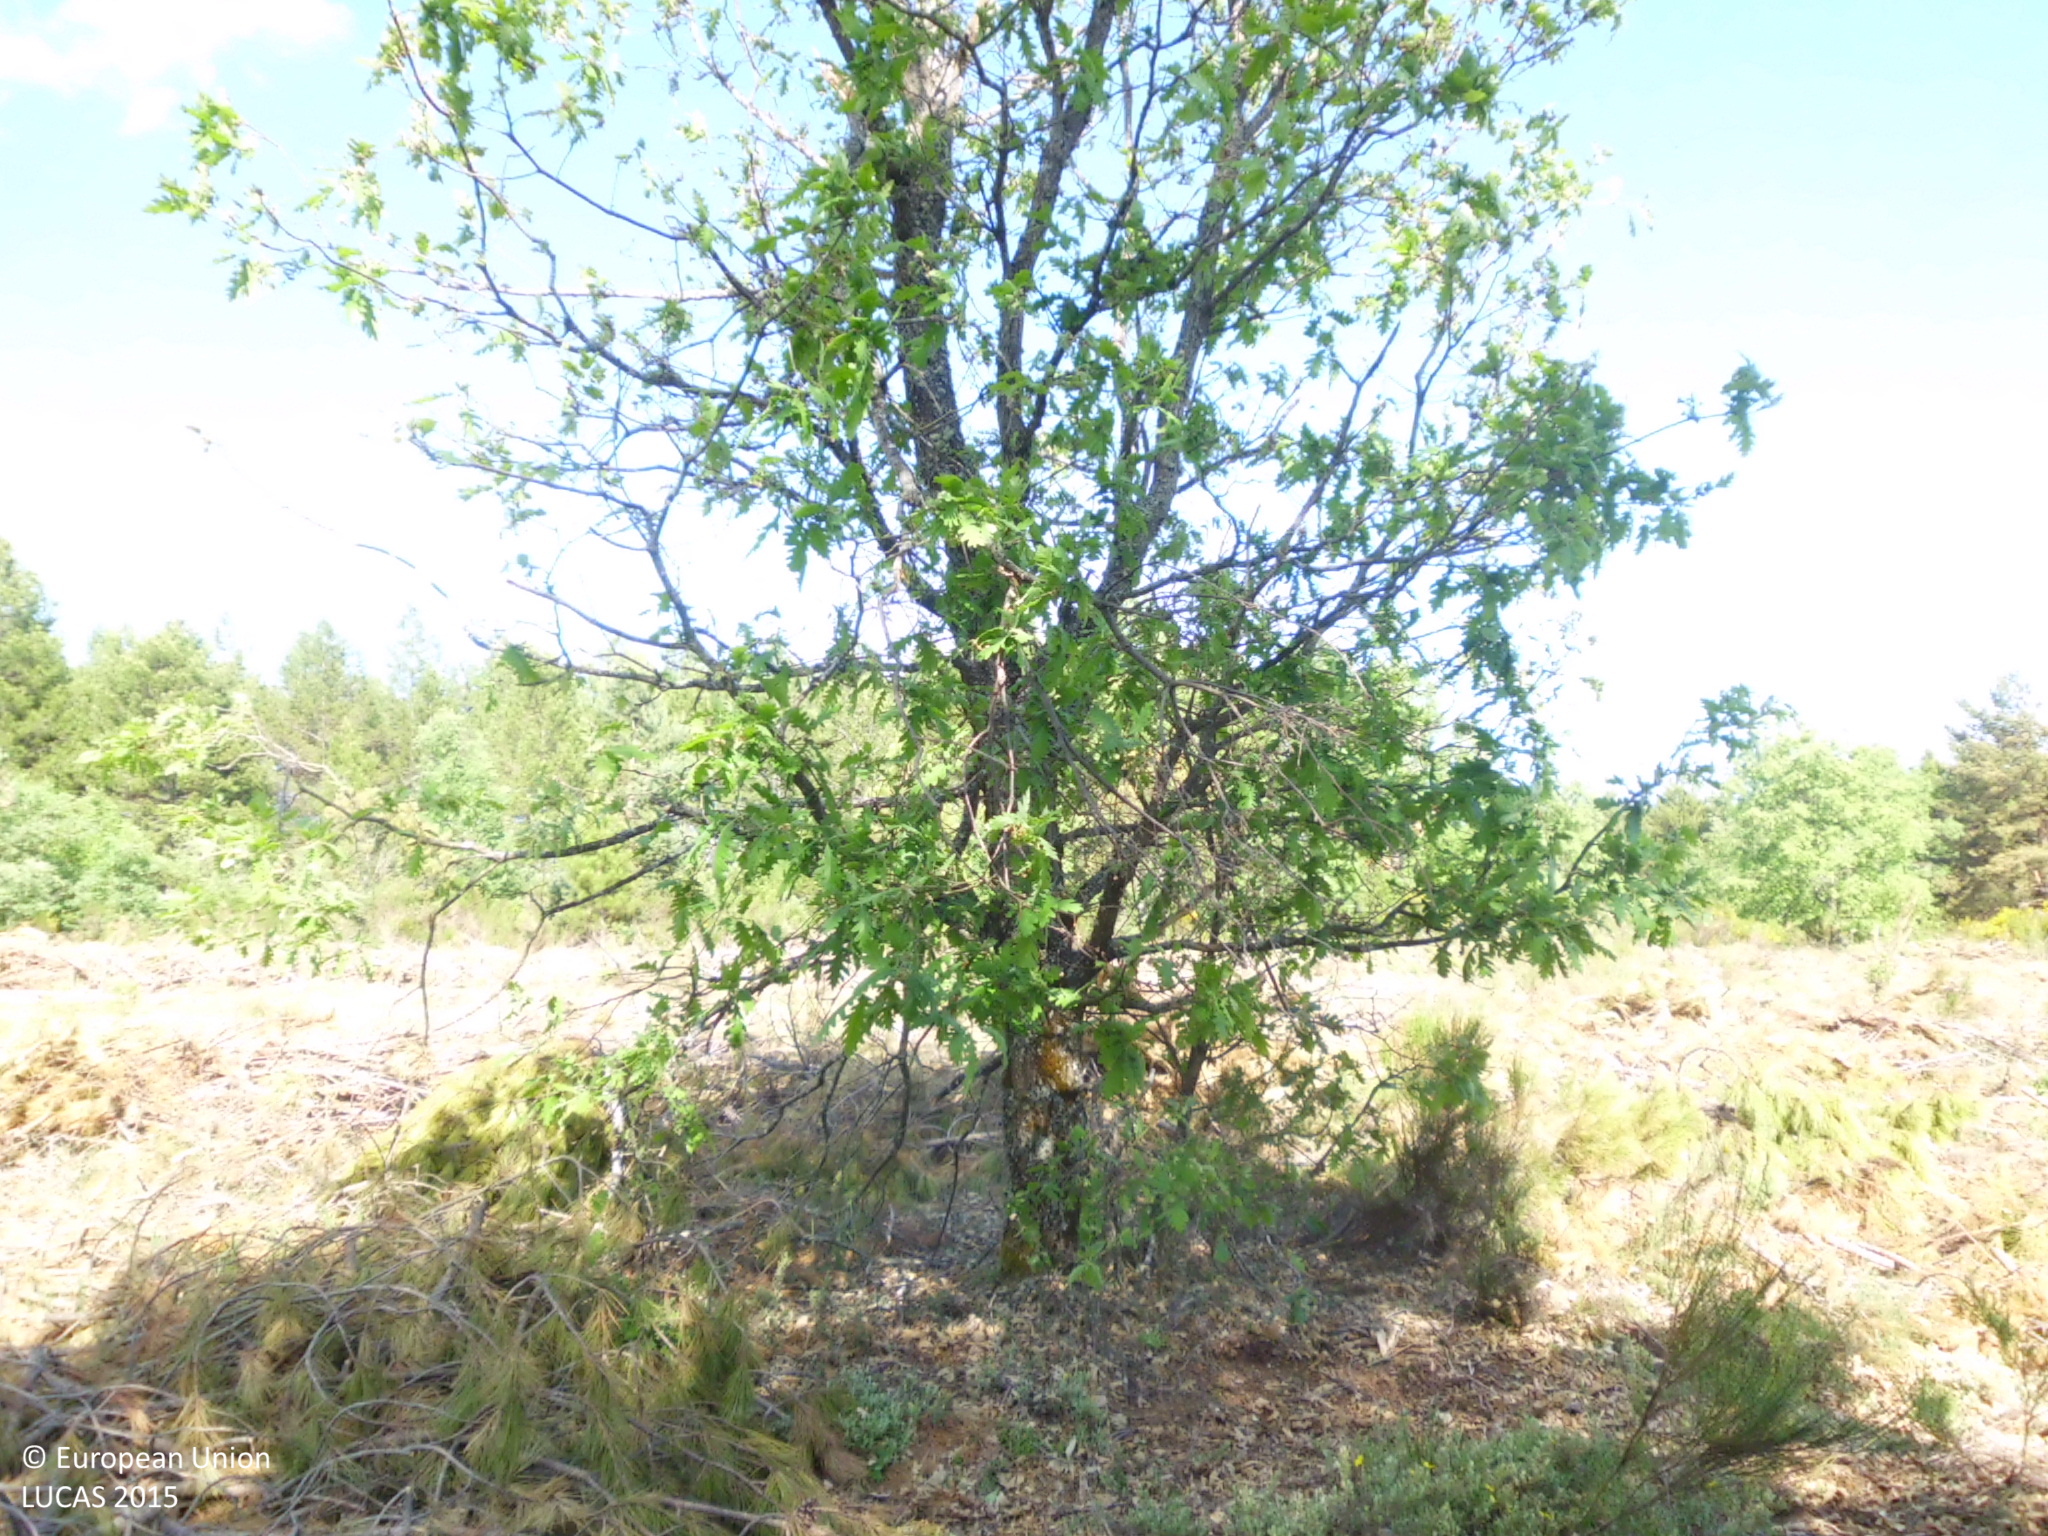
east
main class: Woodland
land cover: Pine dominated mixed woodland
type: coniferous forest of the mediterranean region
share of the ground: 50 - 75 %
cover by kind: coniferous forest trees 45 %, broadleaved forest trees 25 %, herbaceous plants 20 %, shrubs 10 %
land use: Forestry
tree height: > 5 m
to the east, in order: Pine dominated mixed woodland; Broadleaved woodland
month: May
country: ES
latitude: 42.7129
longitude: -5.4190
